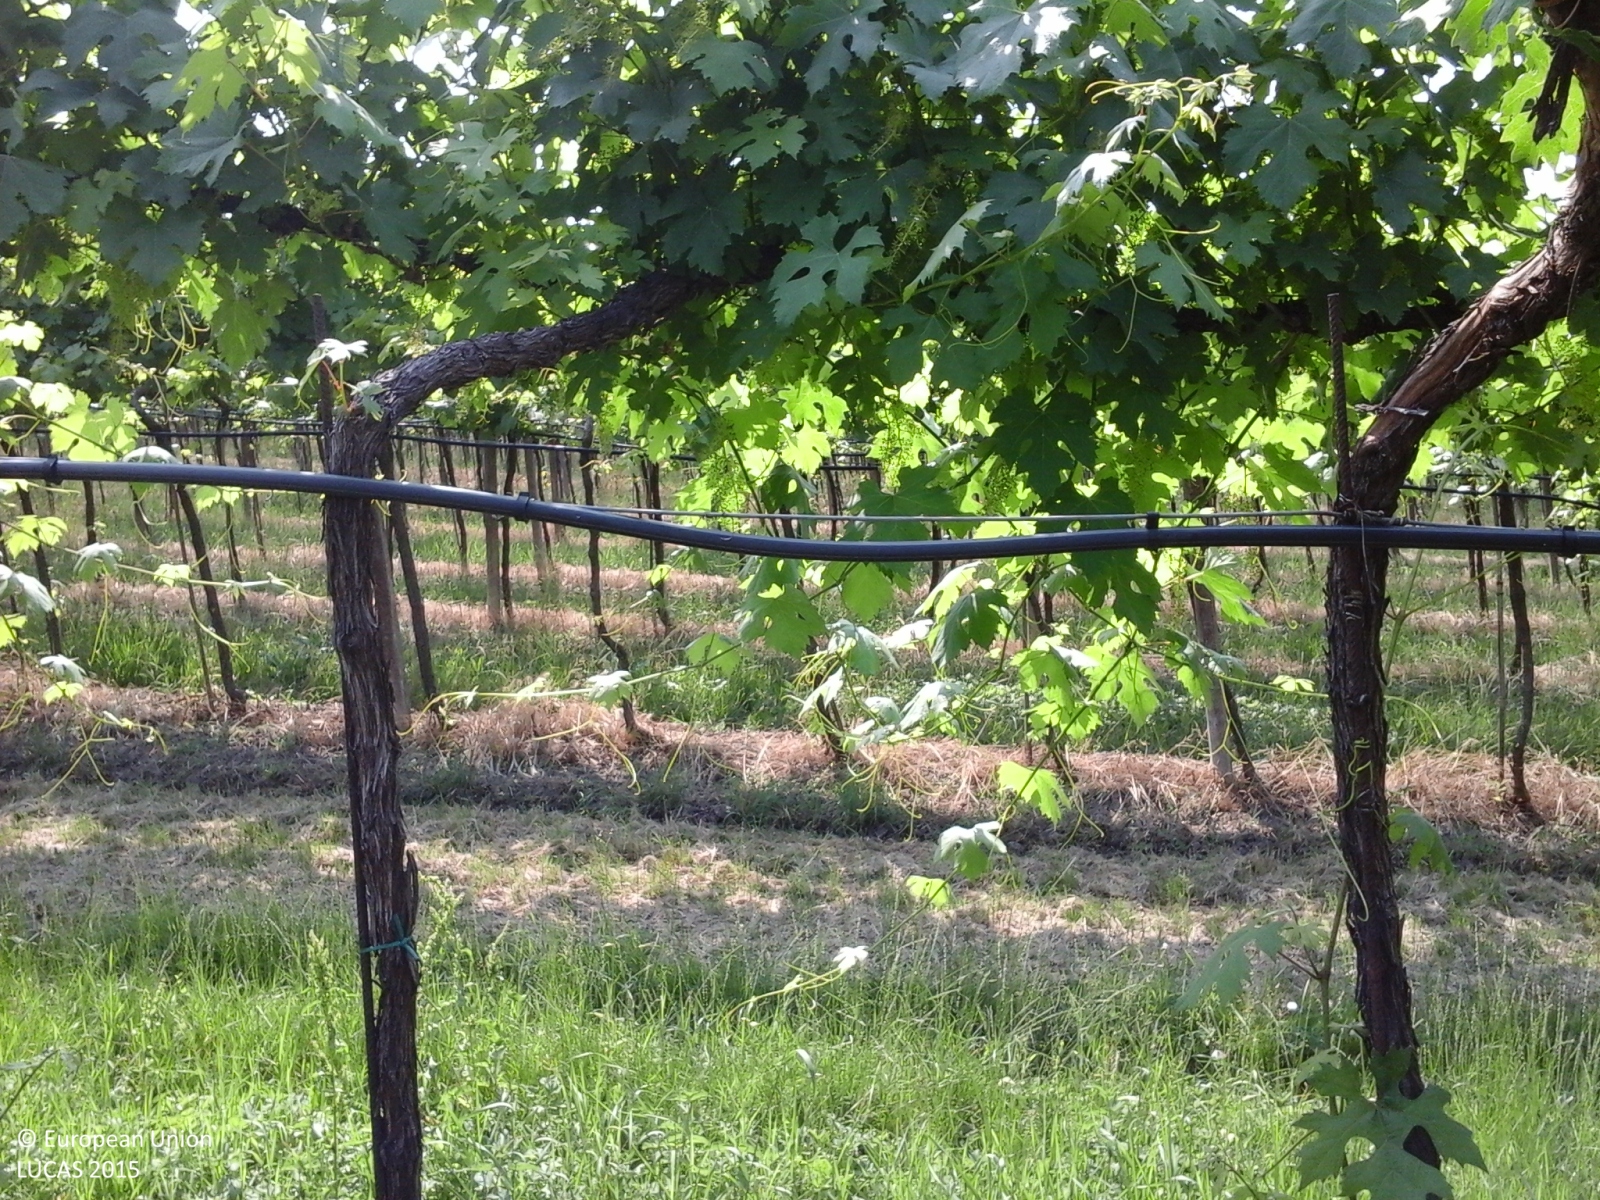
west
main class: Cropland
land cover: Vineyards
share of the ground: 25 - 50 %
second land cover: Grassland without tree/shrub cover
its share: 50 - 75 %
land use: Agriculture (excluding fallow land and kitchen gardens)
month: May
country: IT
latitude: 44.7448
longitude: 10.7184
